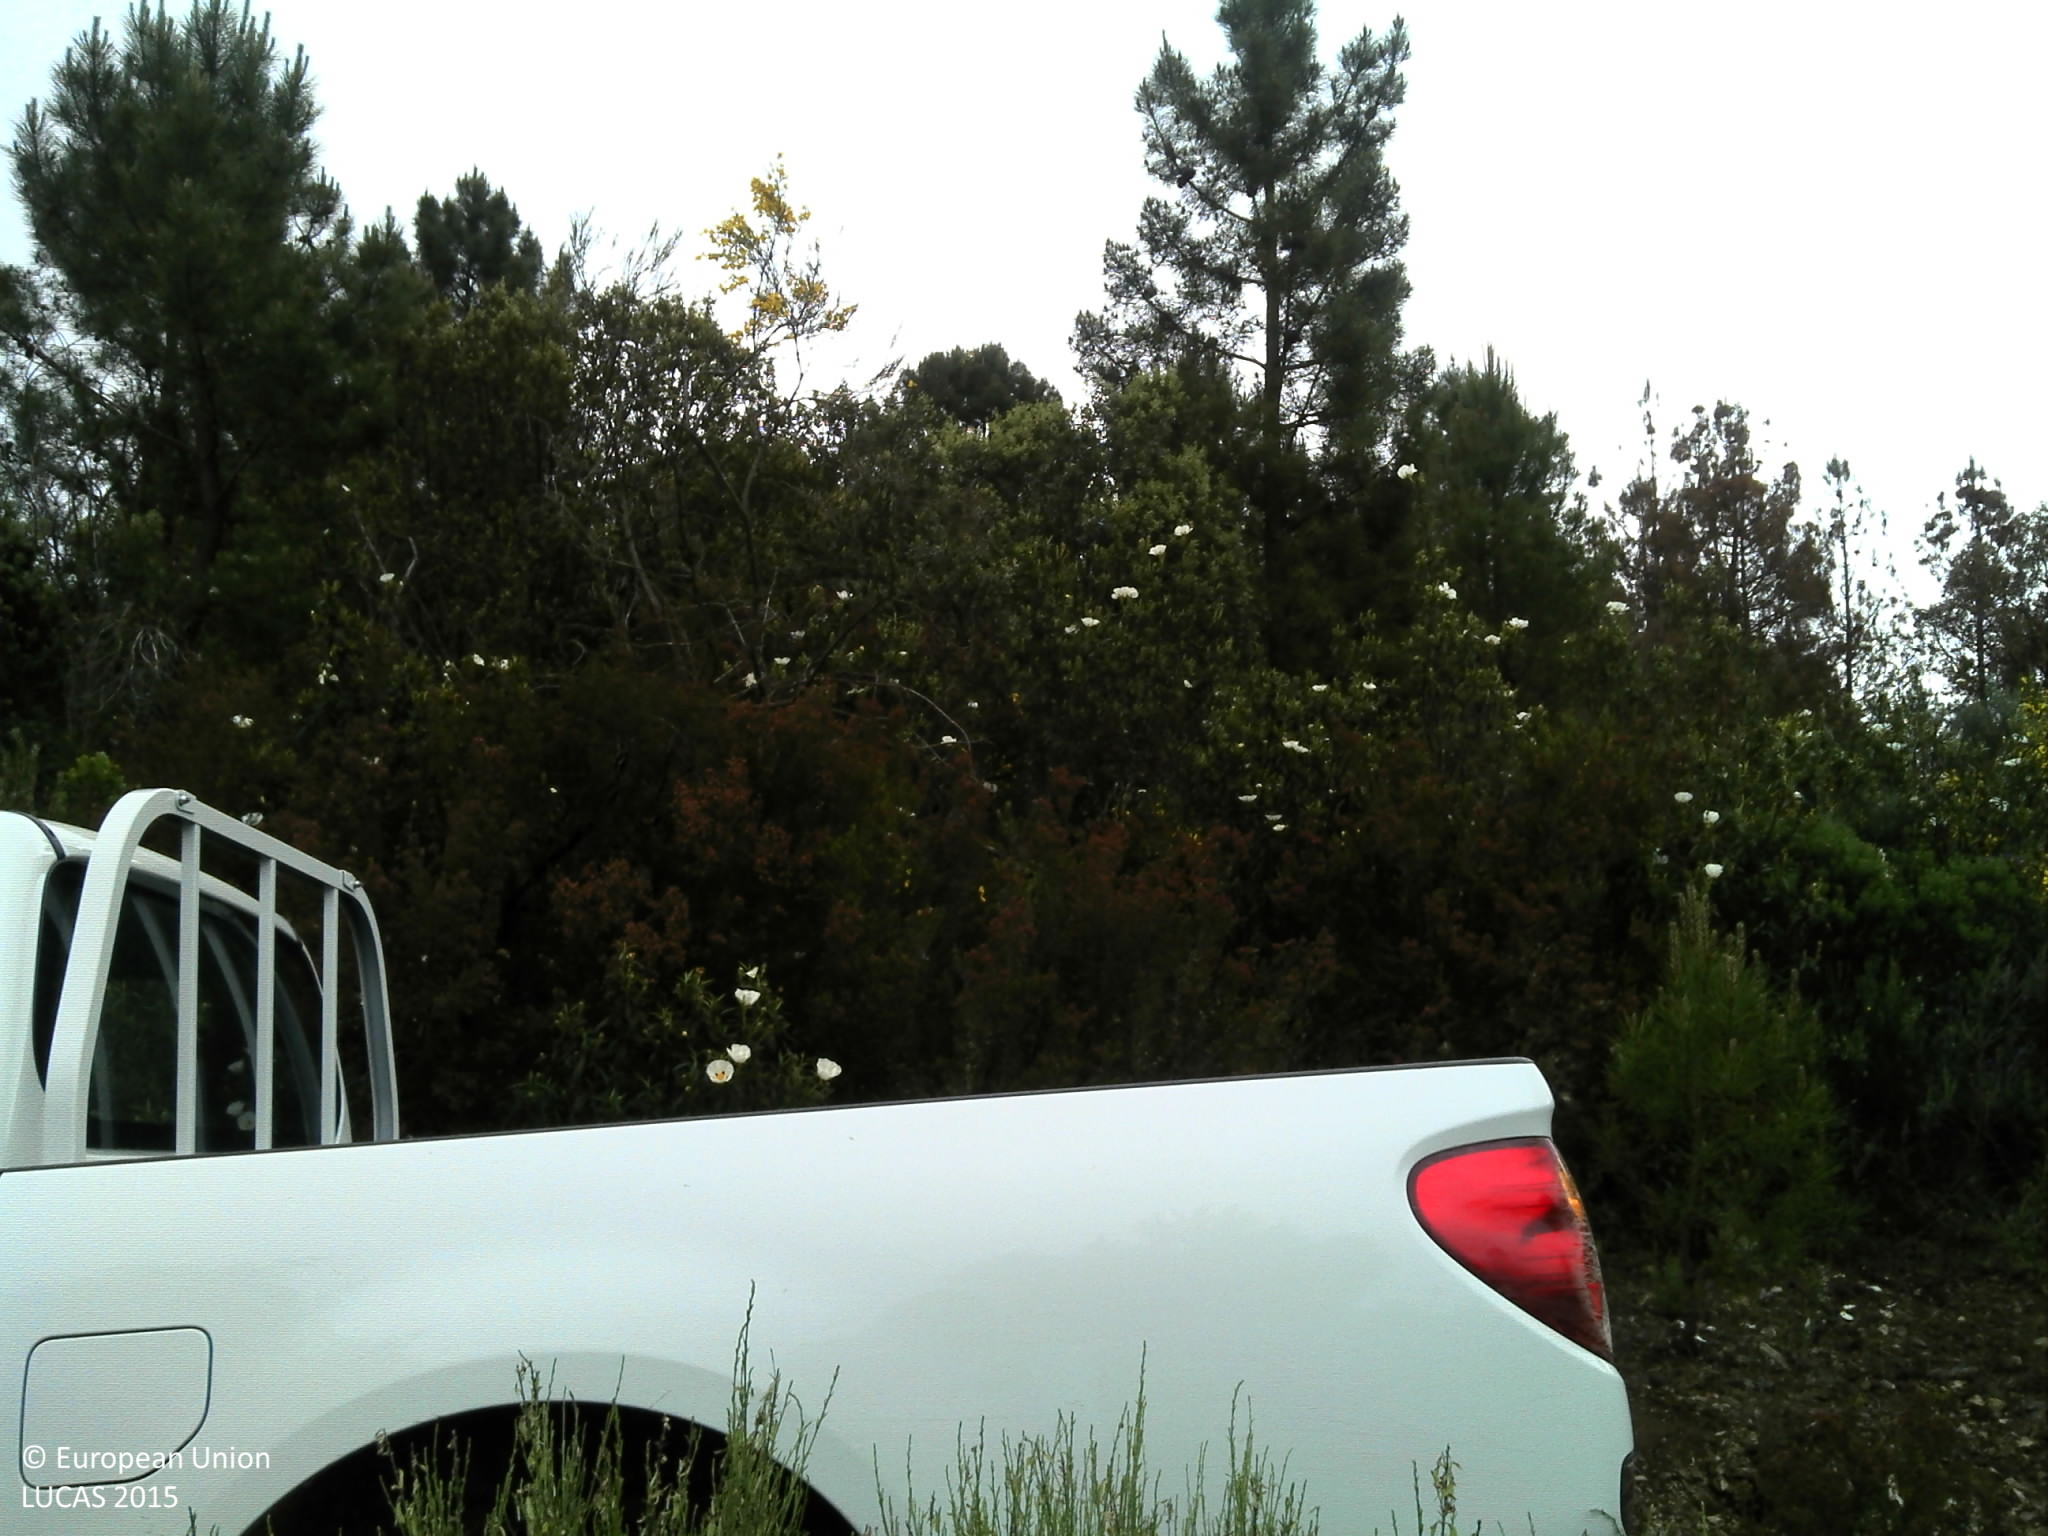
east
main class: Shrubland
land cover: Shrubland without tree cover
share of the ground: > 75 %
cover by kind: shrubs 90 %, herbaceous plants 5 %, unconsolidated bare surface 5 %
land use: Abandoned areas
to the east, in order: Shrubland without tree cover; Shrubland with sparse tree cover; Broadleaved woodland; Tracks; Pine dominated mixed woodland; Shrubland with sparse tree cover; Shrubland without tree cover; Pine dominated mixed woodland; Tracks; Pine dominated mixed woodland
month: May
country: PT
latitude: 41.6880
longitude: -6.9727
